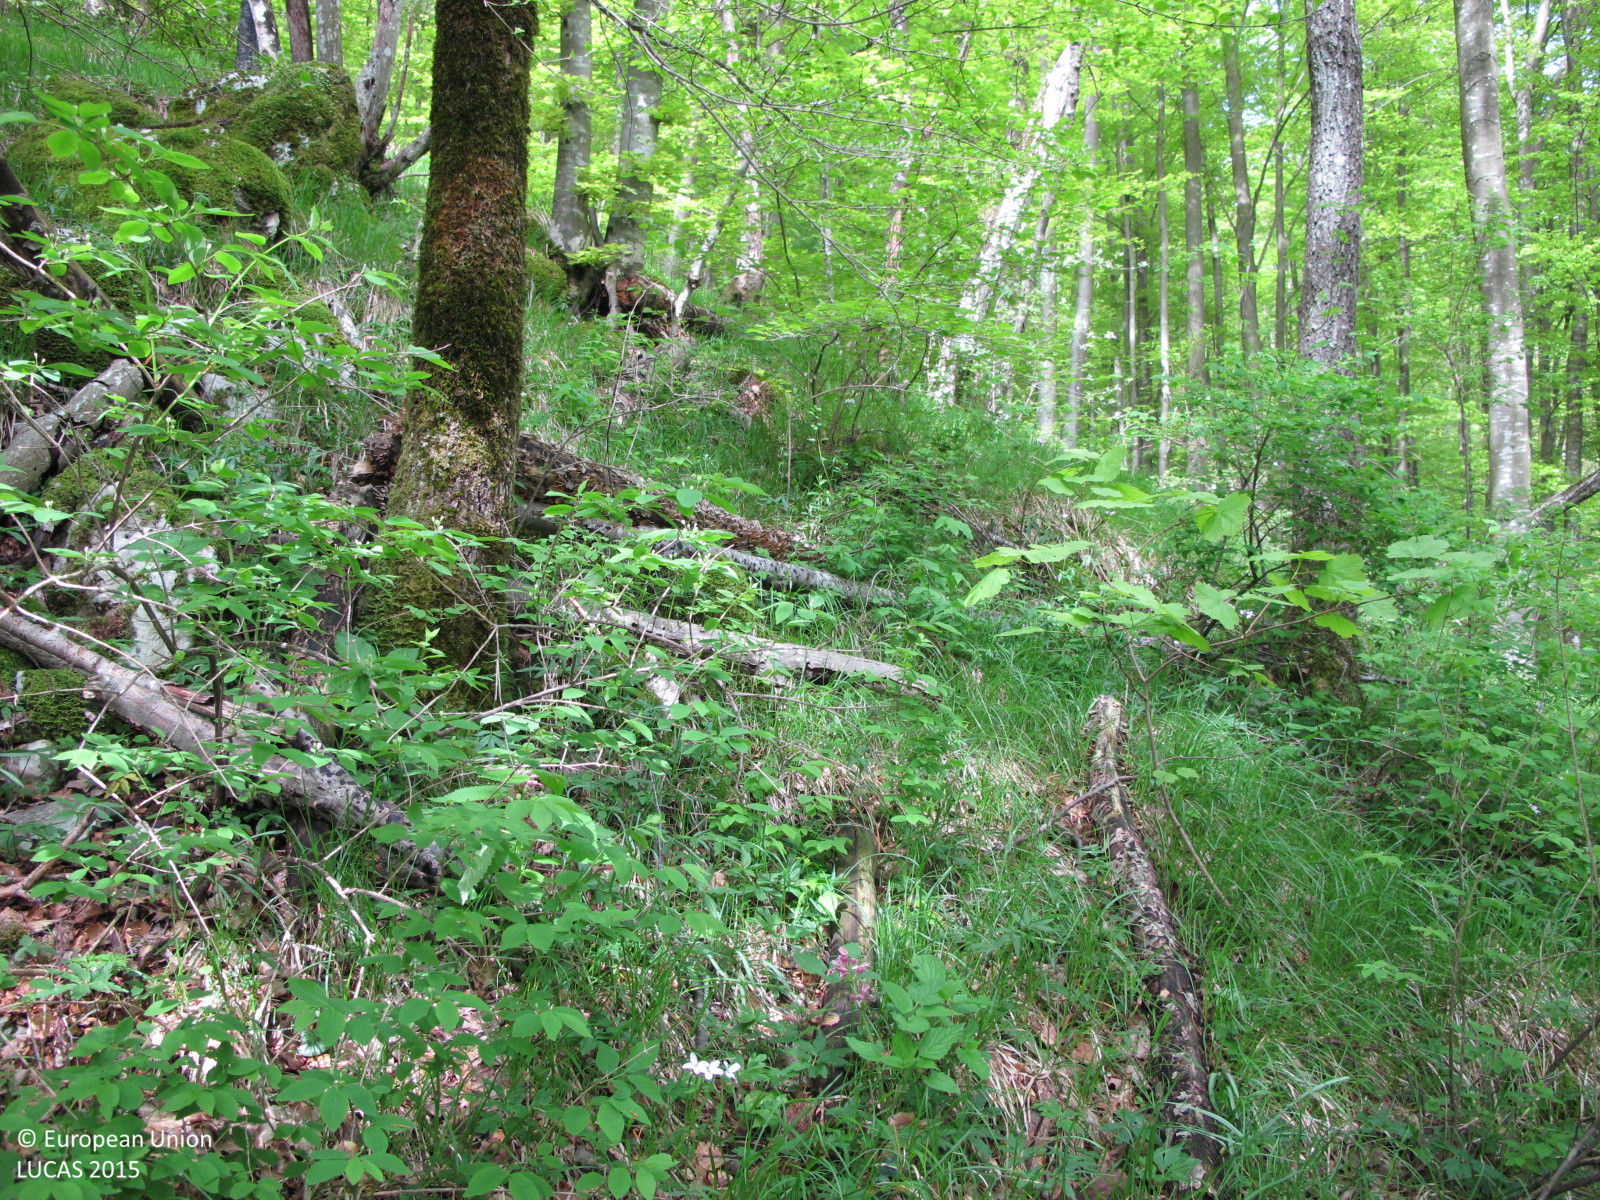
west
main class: Woodland
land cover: Broadleaved woodland
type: beech forest
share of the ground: > 75 %
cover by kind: broadleaved forest trees 80 %, herbaceous plants 10 %, shrubs 5 %
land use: Forestry
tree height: > 5 m
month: May
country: HR
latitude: 45.3289
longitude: 14.2437
